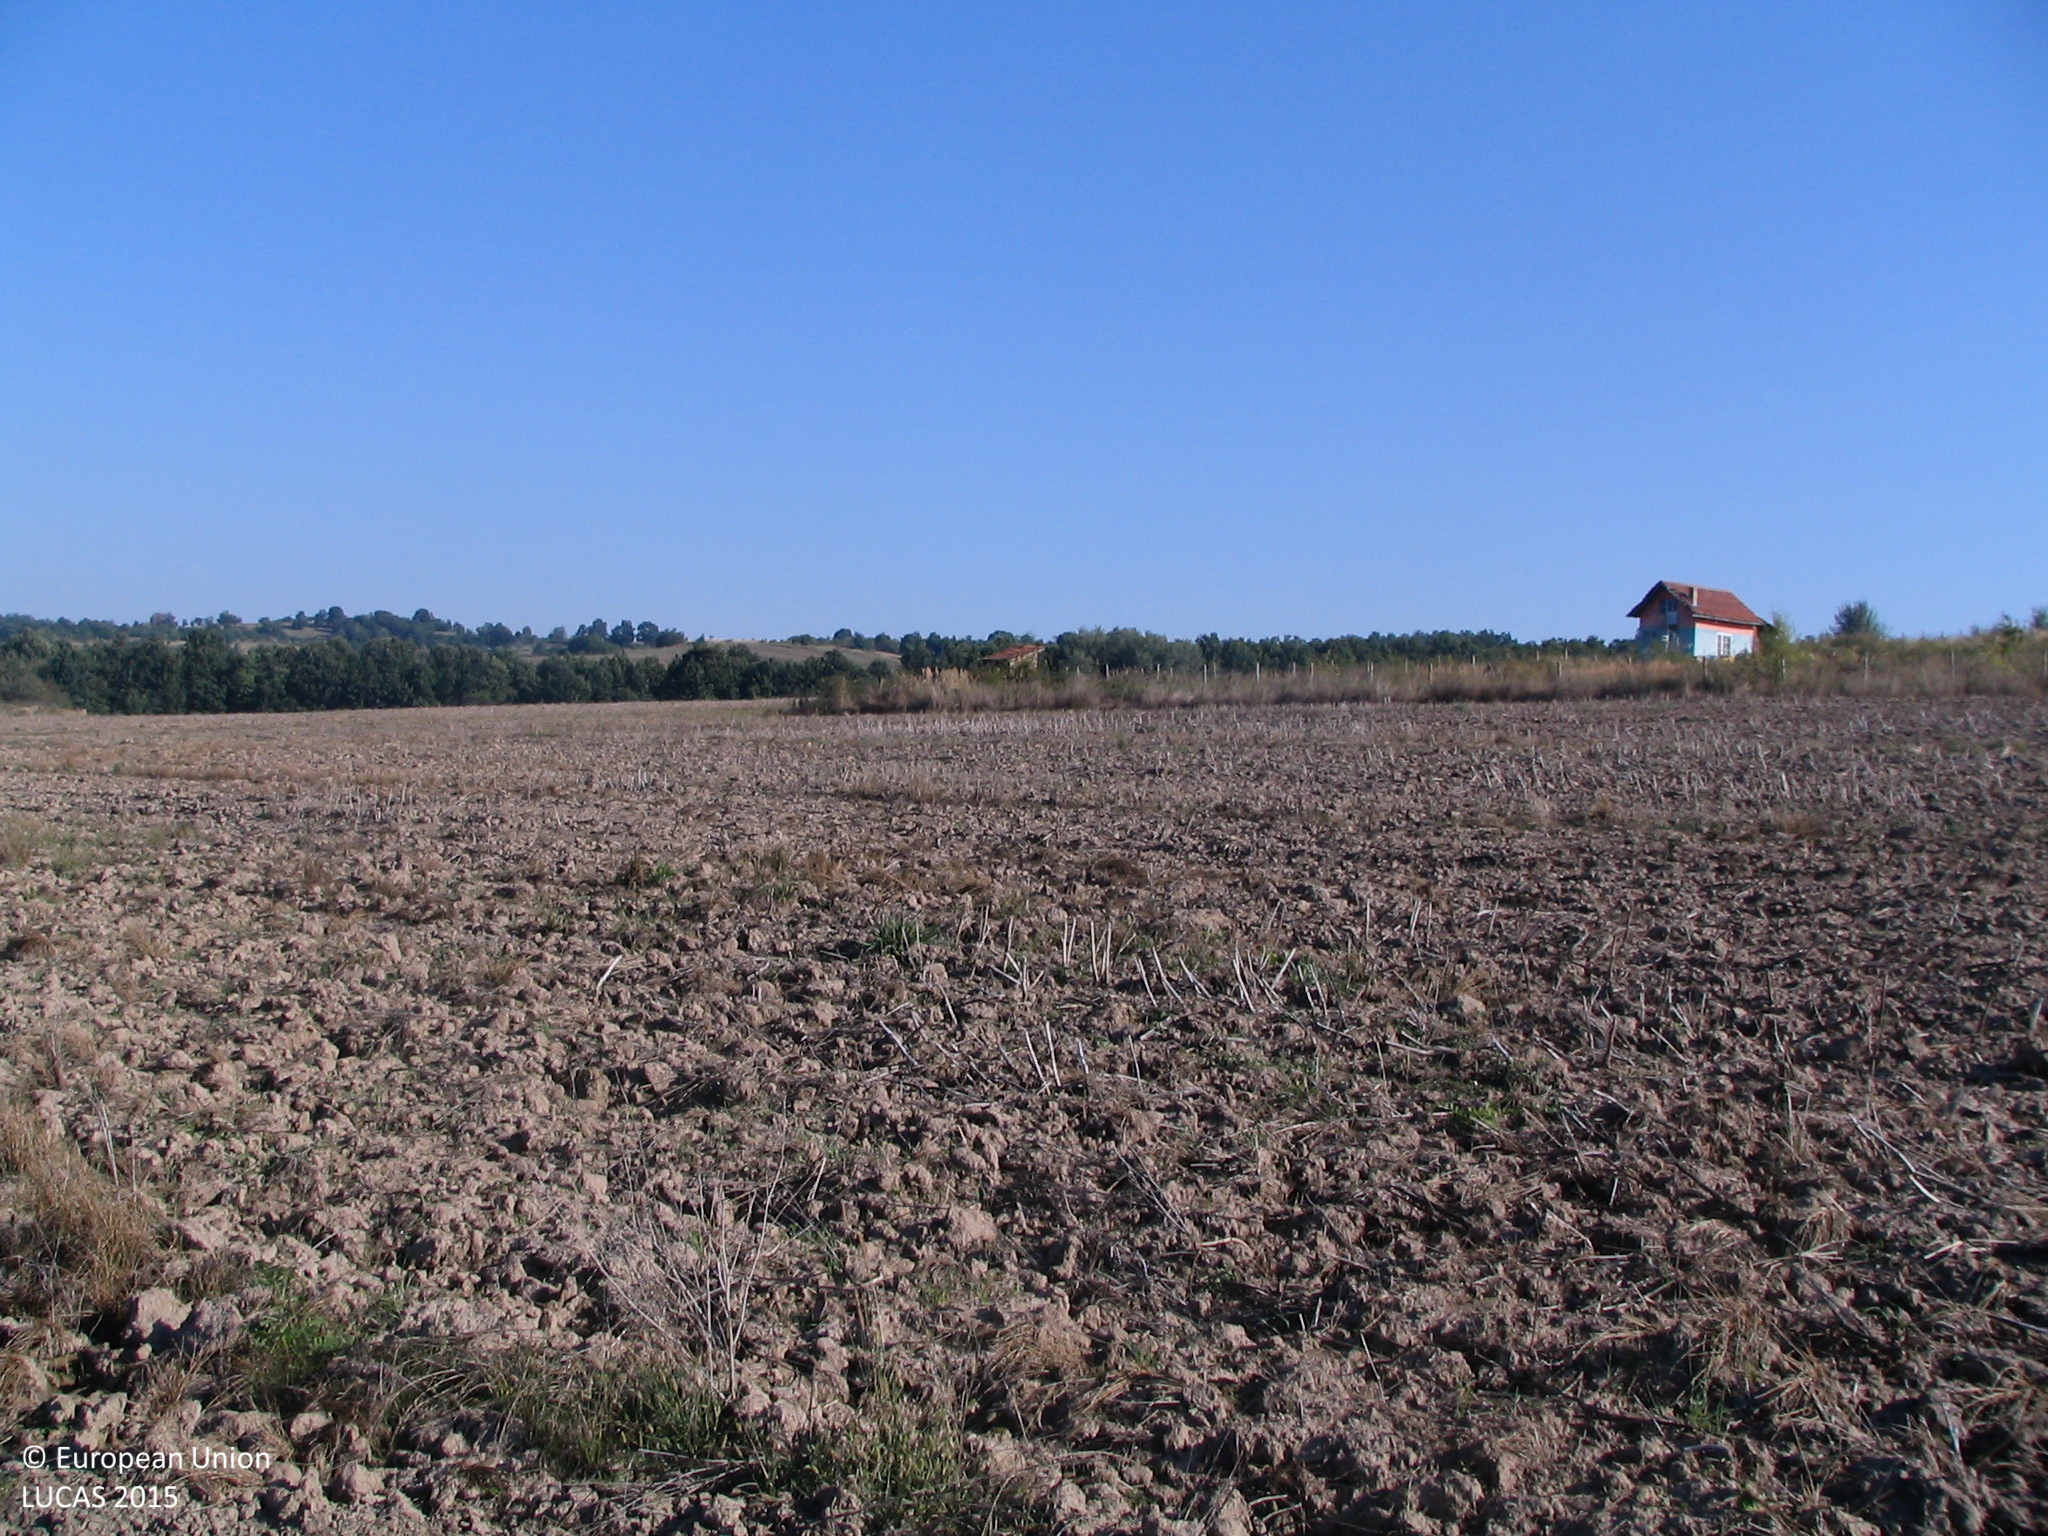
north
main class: Cropland
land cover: Common wheat
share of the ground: < 10 %
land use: Agriculture (excluding fallow land and kitchen gardens)
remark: Harvested field
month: August
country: BG
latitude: 43.0748
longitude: 24.4629
